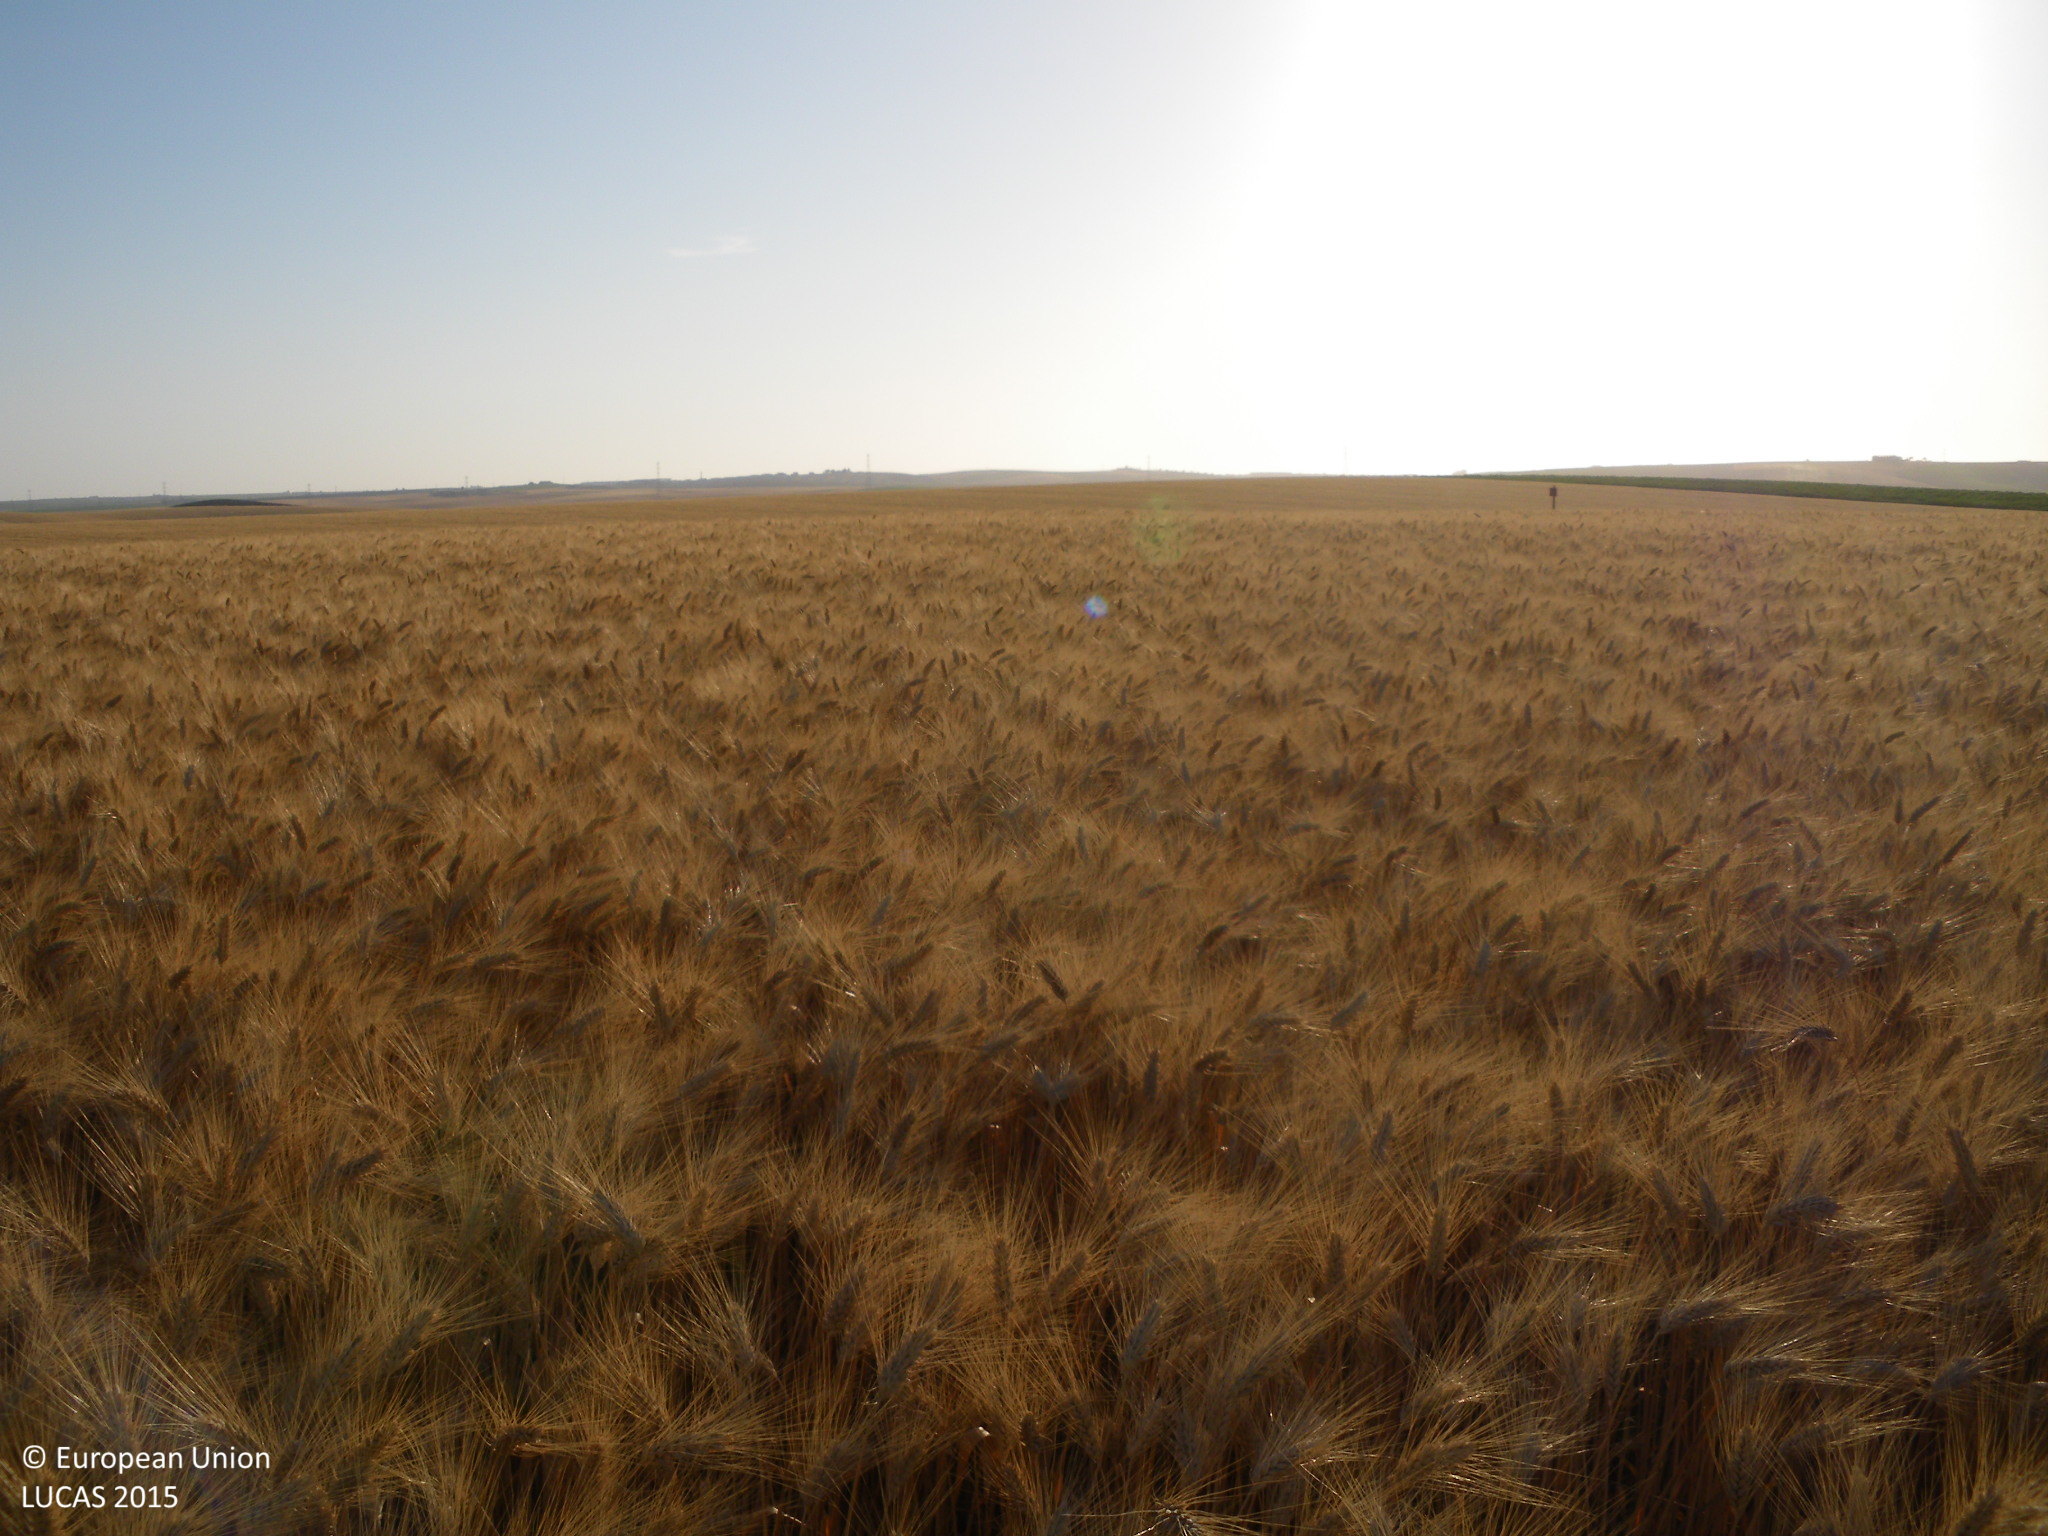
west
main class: Cropland
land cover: Durum wheat
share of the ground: > 75 %
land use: Agriculture (excluding fallow land and kitchen gardens)
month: May
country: ES
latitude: 36.7606
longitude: -6.2700
